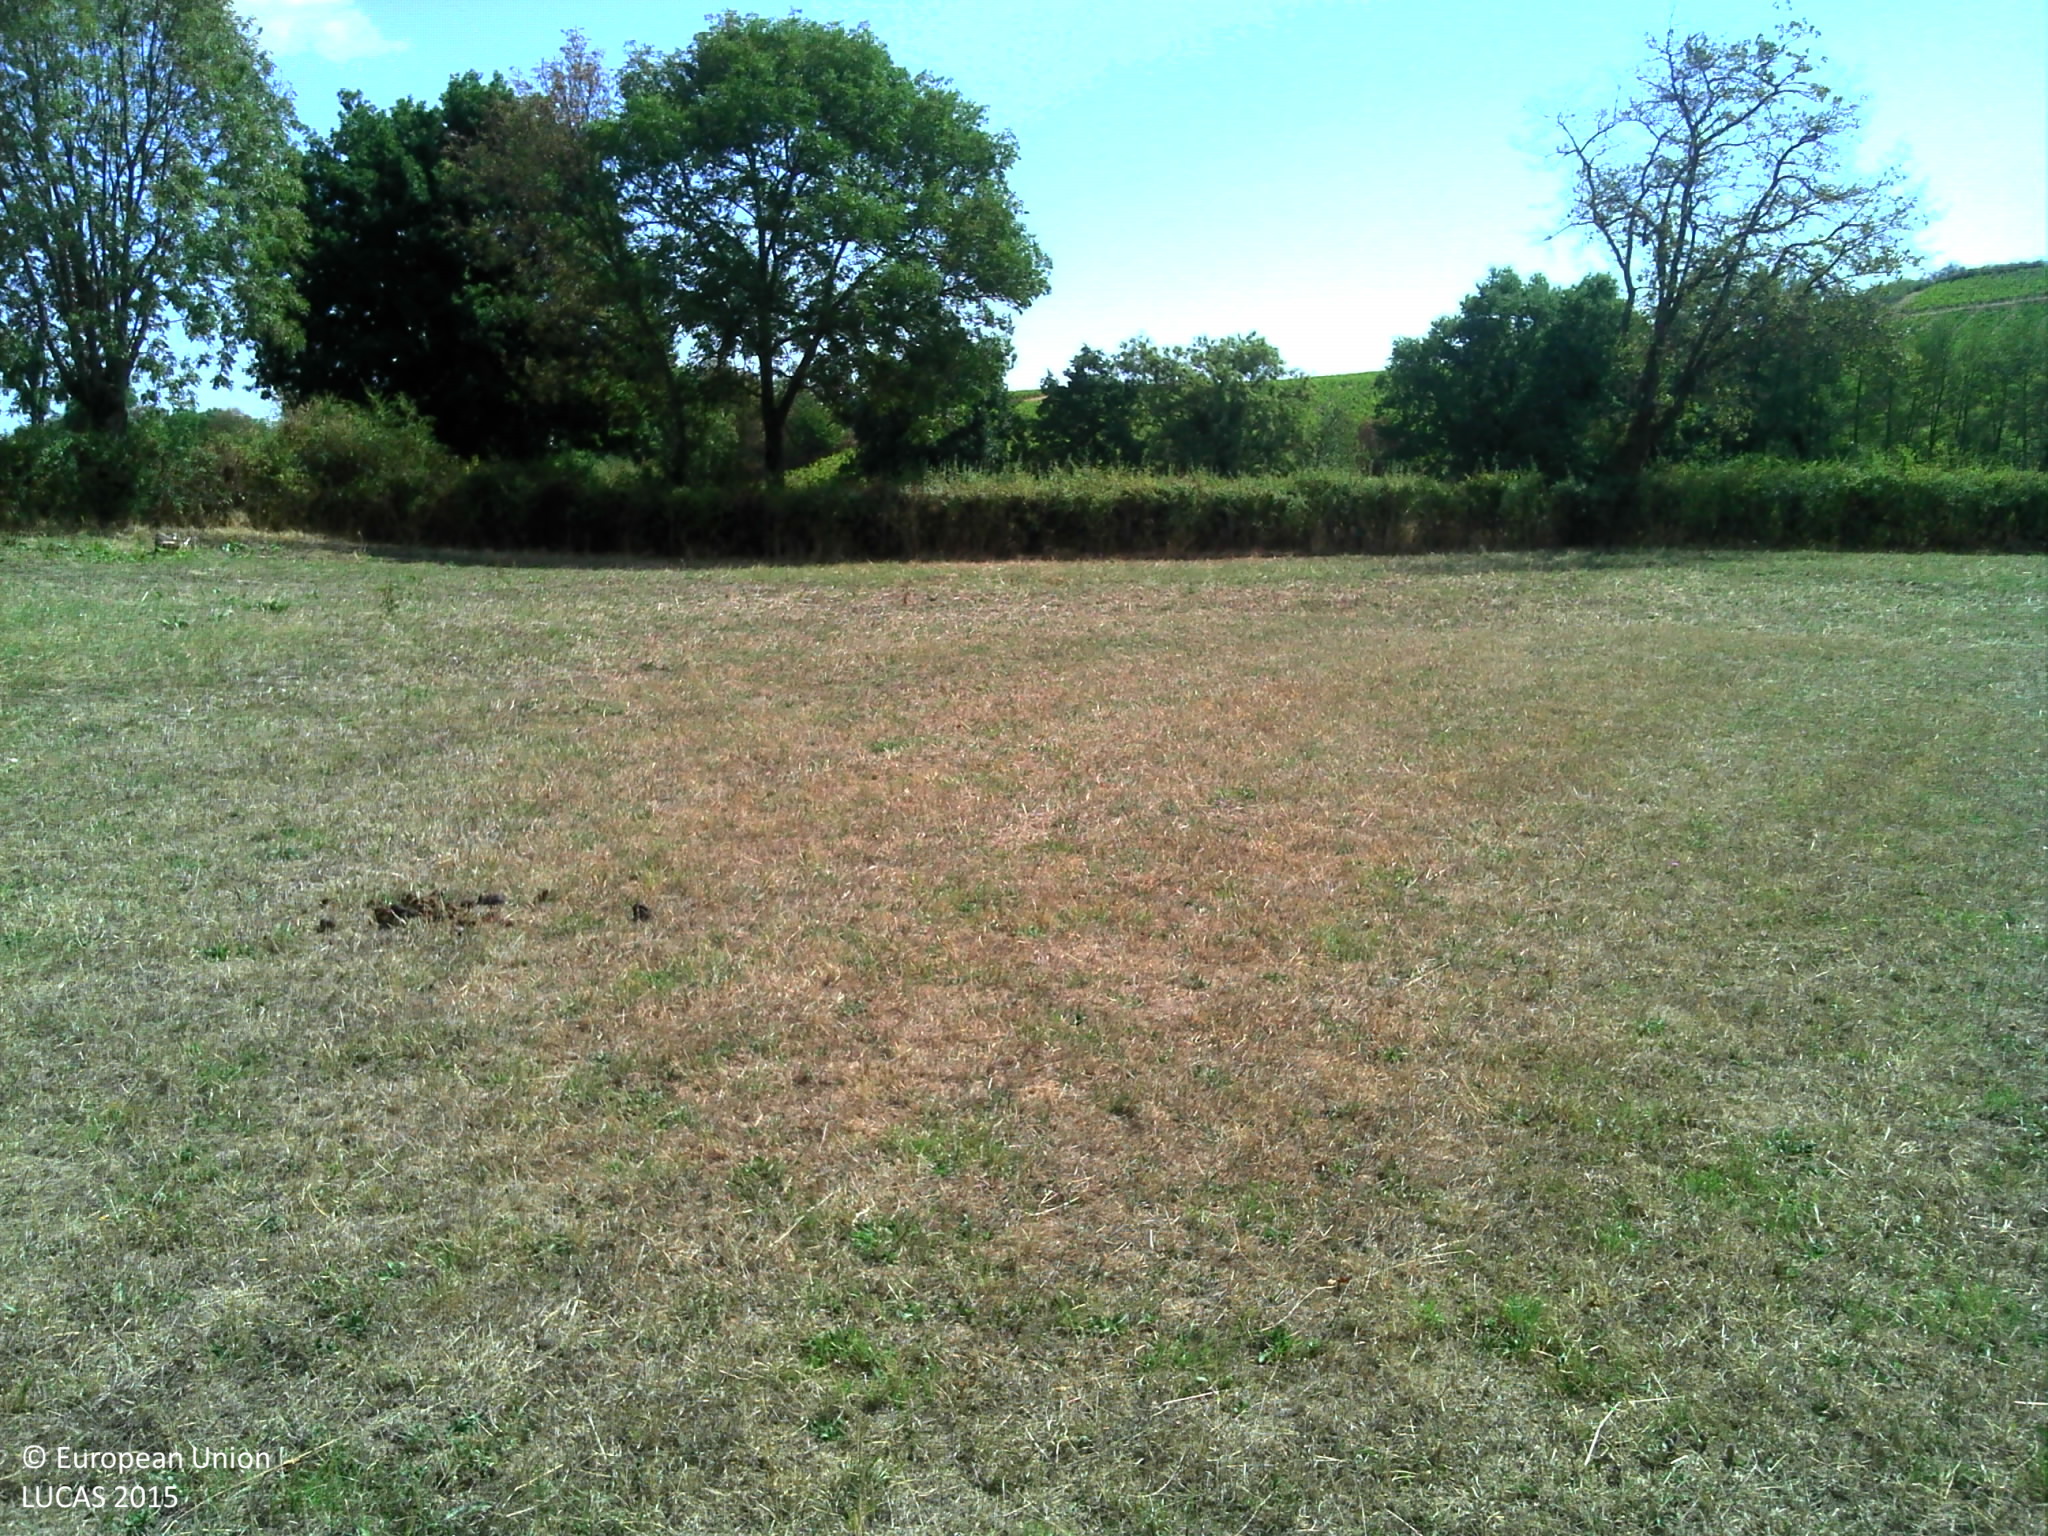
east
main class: Grassland
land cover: Grassland without tree/shrub cover
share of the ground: > 75 %
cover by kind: herbaceous plants 100 %
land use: Agriculture (excluding fallow land and kitchen gardens)
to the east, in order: Grassland without tree/shrub cover; Abandoned hedges; Fences; Grassland without tree/shrub cover; Fences; Abandoned hedges; Grassland without tree/shrub cover; Rivers and streams; Grassland without tree/shrub cover; Abandoned hedges; Dry stone walls; Grass margins; Vineyards; Grassland without tree/shrub cover; Vineyards
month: August
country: FR
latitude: 46.1454
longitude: 4.6555
